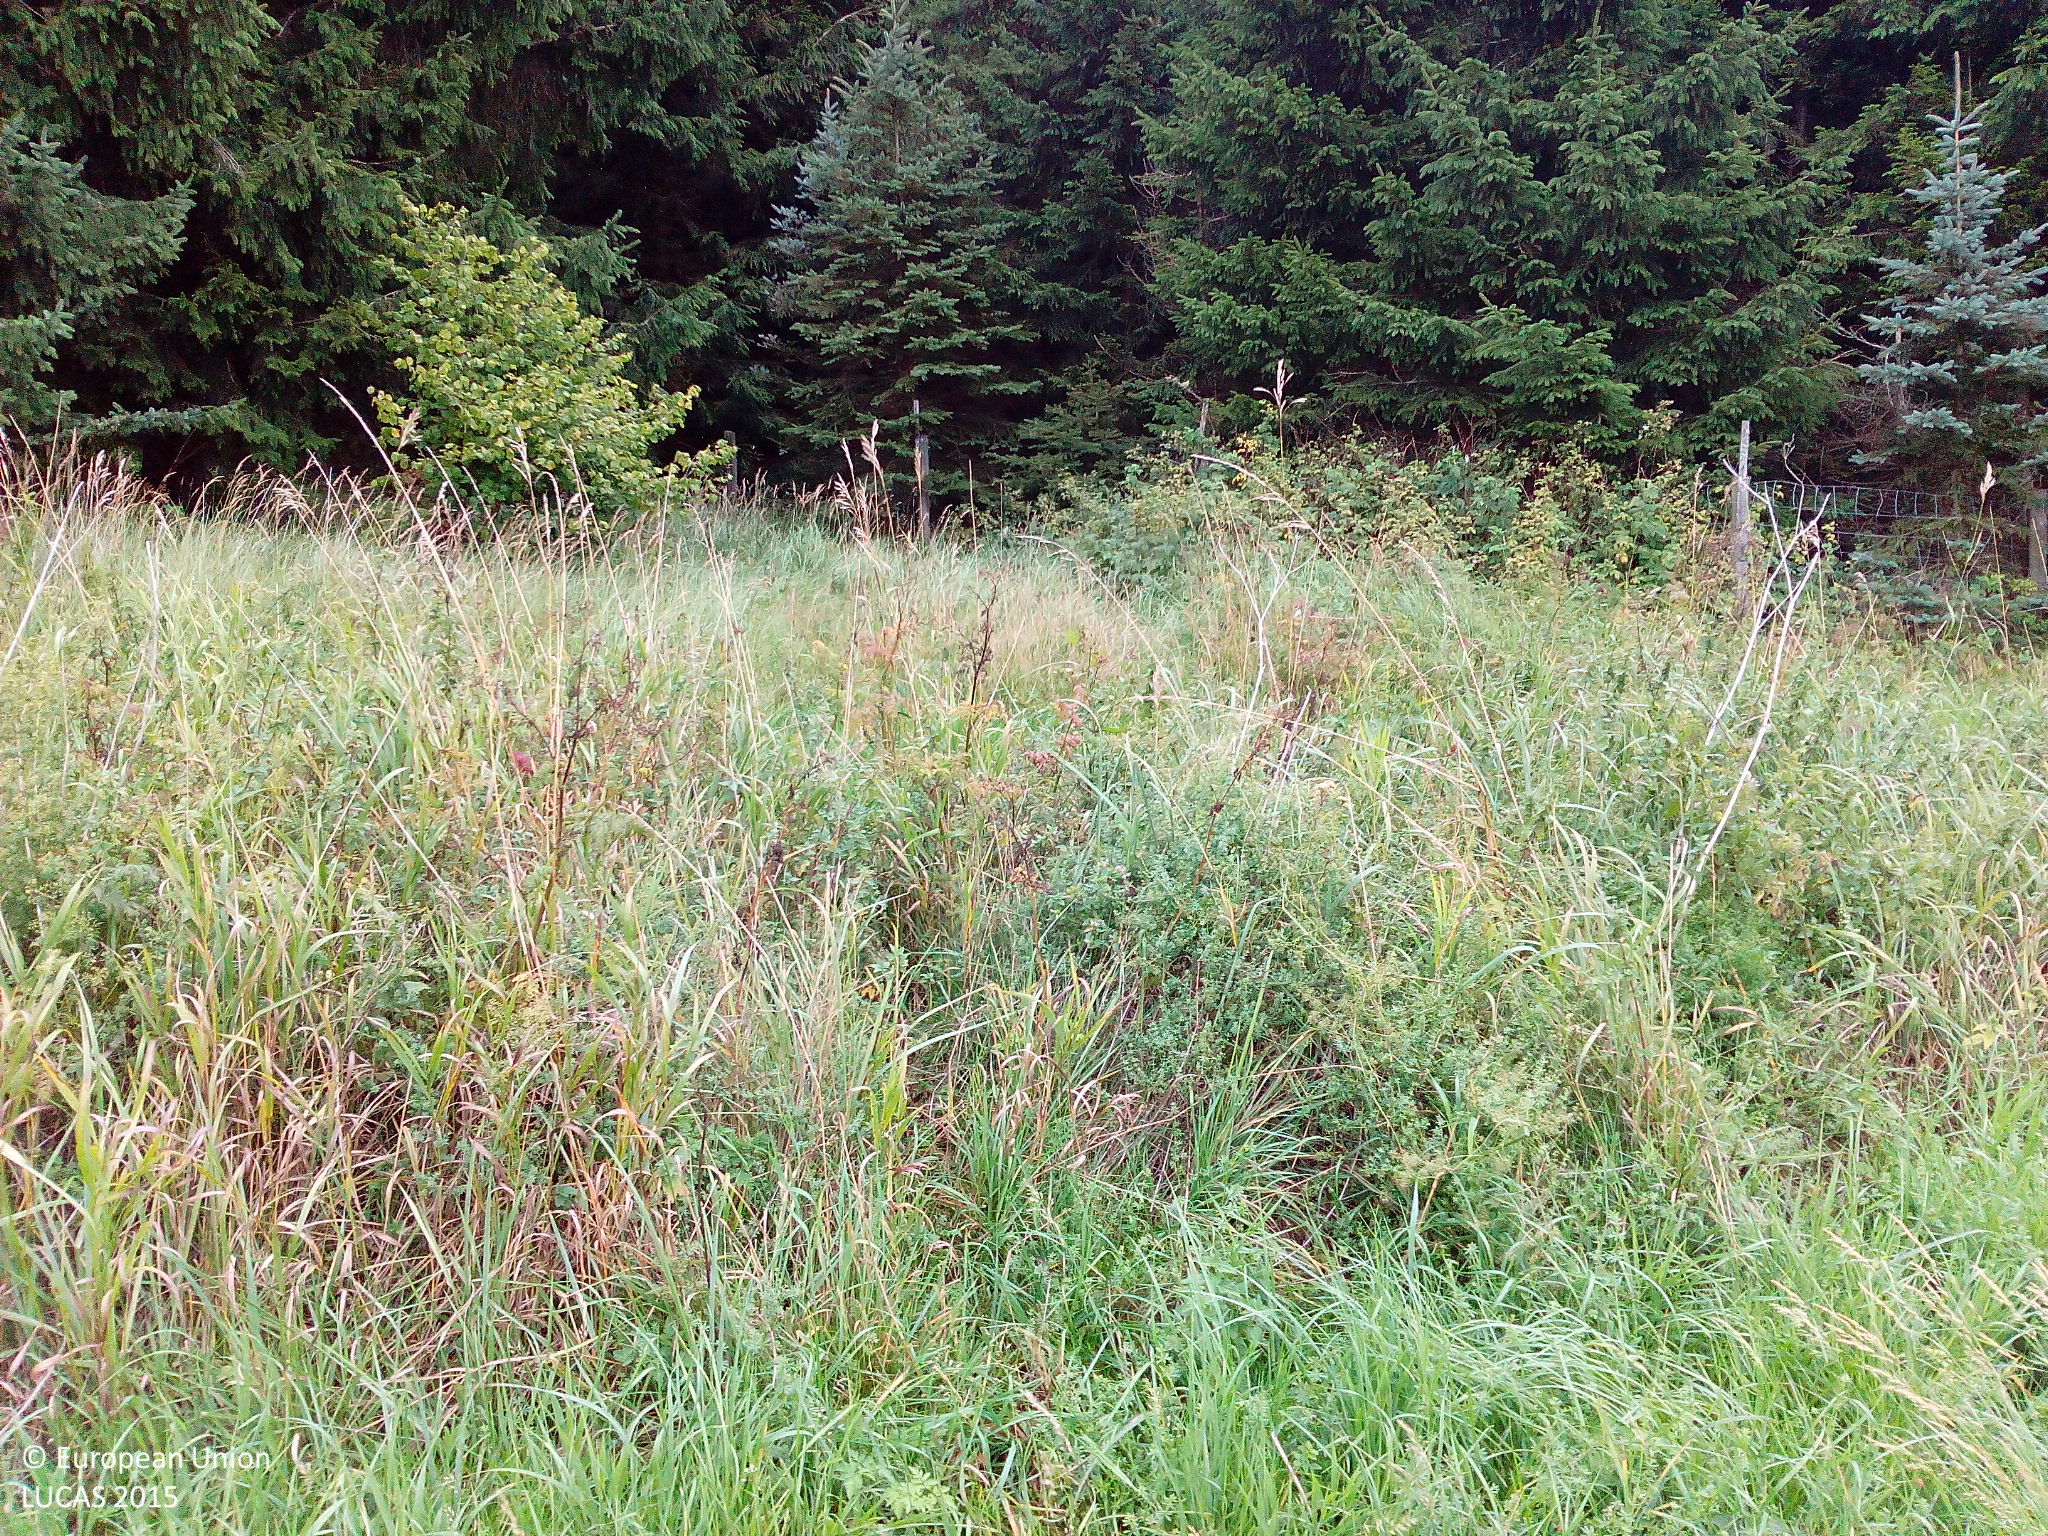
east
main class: Grassland
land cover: Grassland without tree/shrub cover
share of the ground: > 75 %
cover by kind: herbaceous plants 100 %
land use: Agriculture (excluding fallow land and kitchen gardens)
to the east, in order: Grassland without tree/shrub cover; Tracks; Grass margins; Spruce dominated coniferous woodland; Tracks; Fences; Spruce dominated coniferous woodland; Spruce dominated mixed woodland; Broadleaved woodland; Tracks; Broadleaved woodland
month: August
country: DE
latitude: 50.4871
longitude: 9.1969
